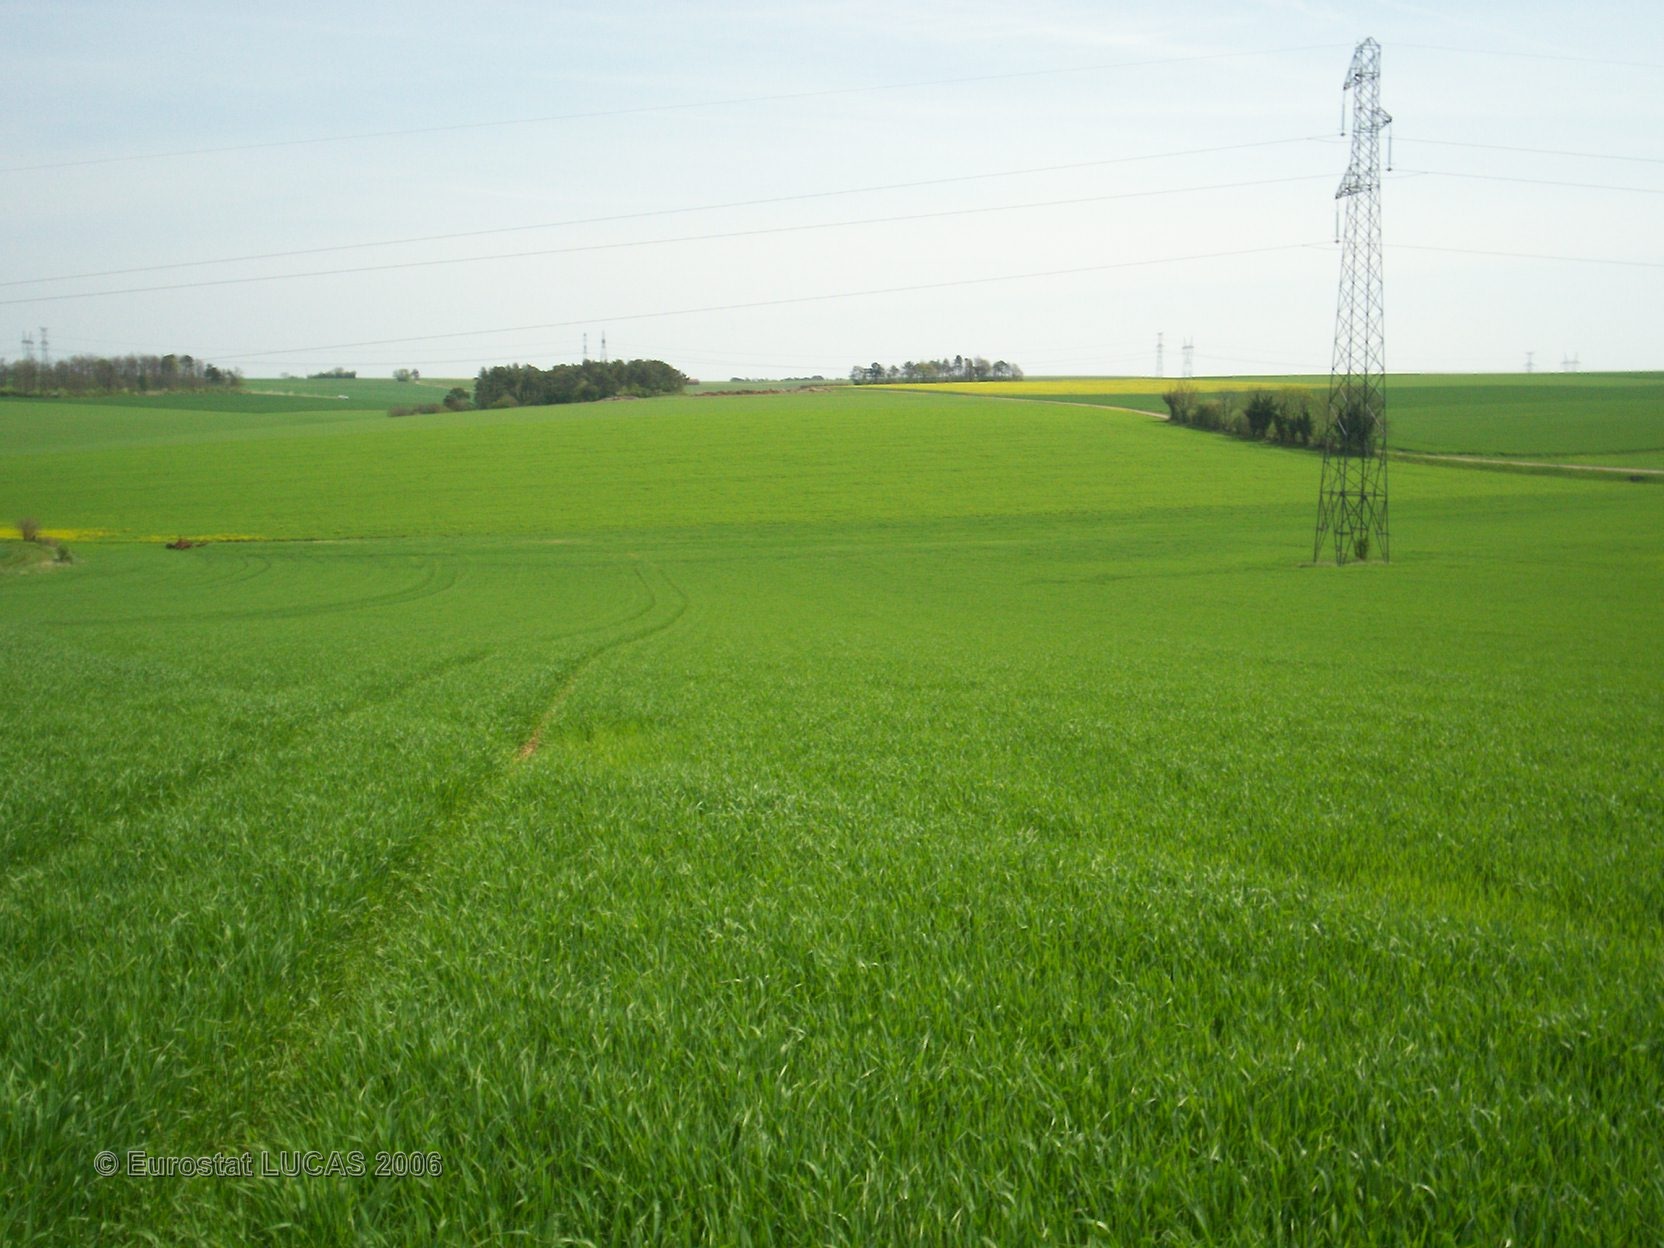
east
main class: Cropland
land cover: Barley
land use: Agriculture (excluding fallow land and kitchen gardens)
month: May
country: FR
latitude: 47.6188
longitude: 4.5305
